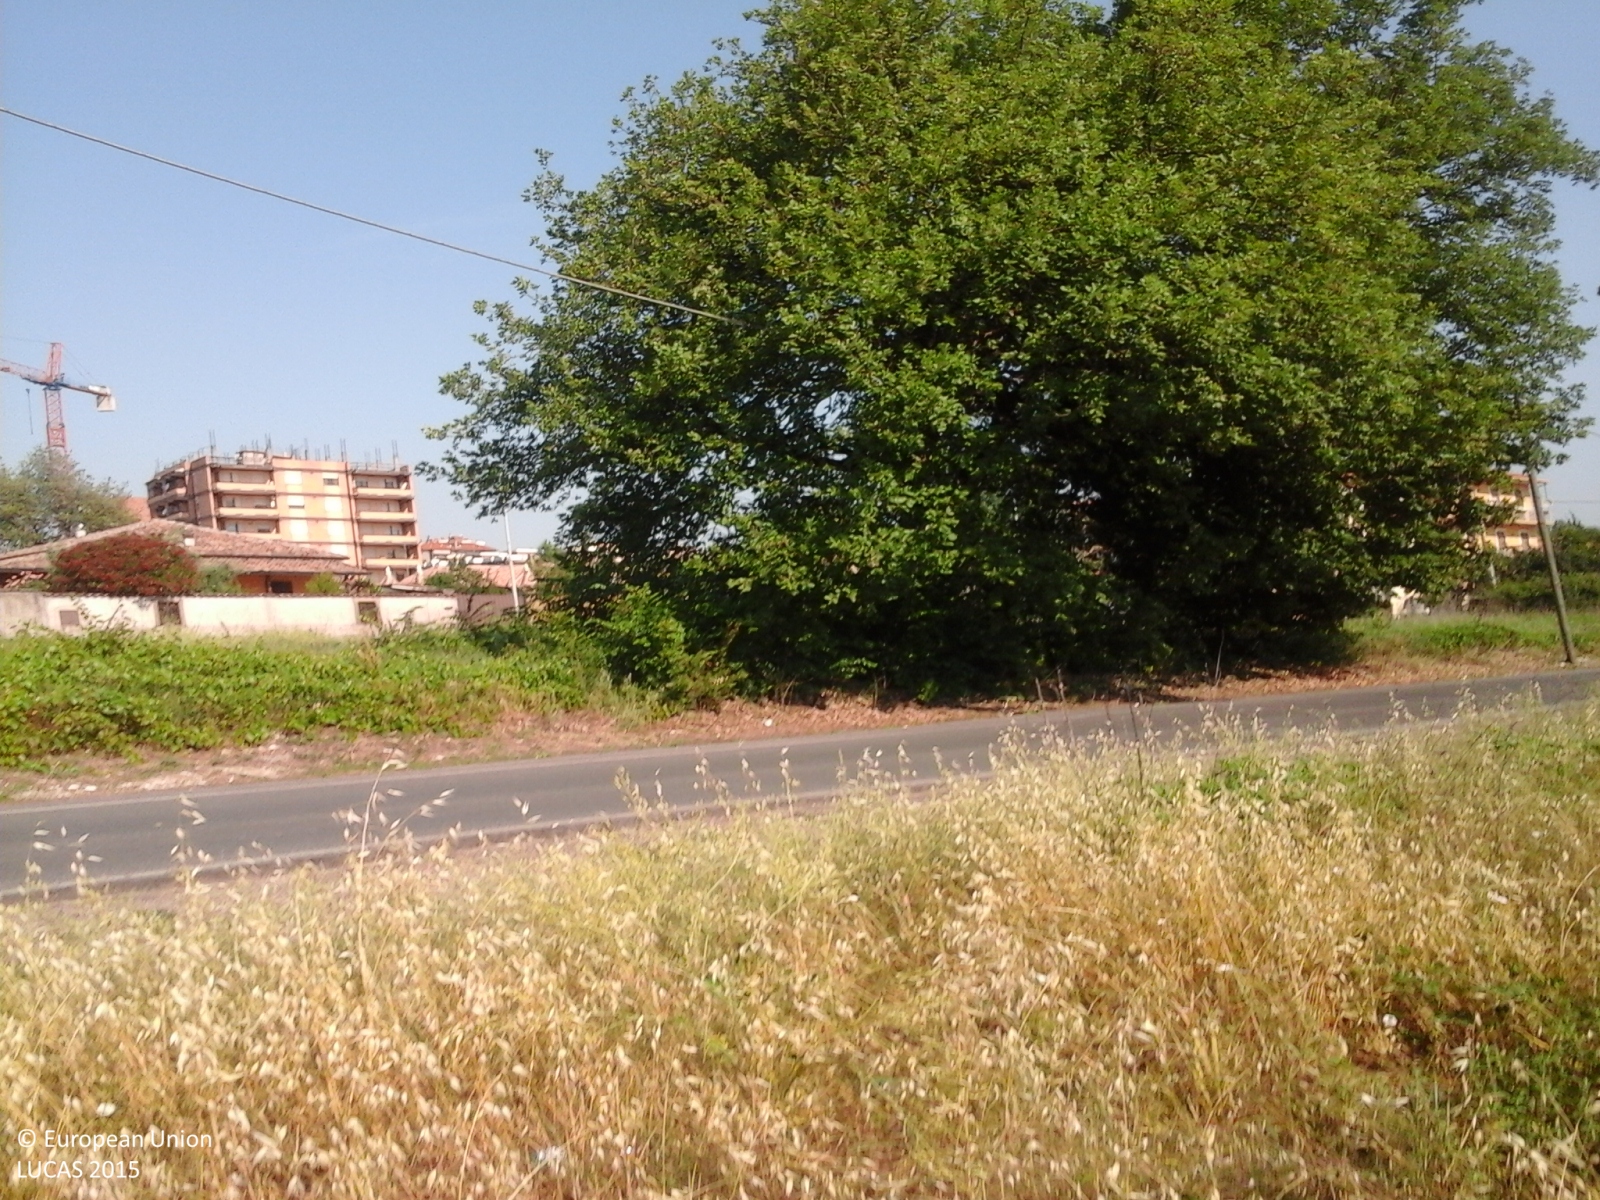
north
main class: Grassland
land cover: Grassland without tree/shrub cover
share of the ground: > 75 %
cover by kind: herbaceous plants 100 %
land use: Agriculture (excluding fallow land and kitchen gardens)
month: May
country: IT
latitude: 41.6407
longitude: 13.3369
